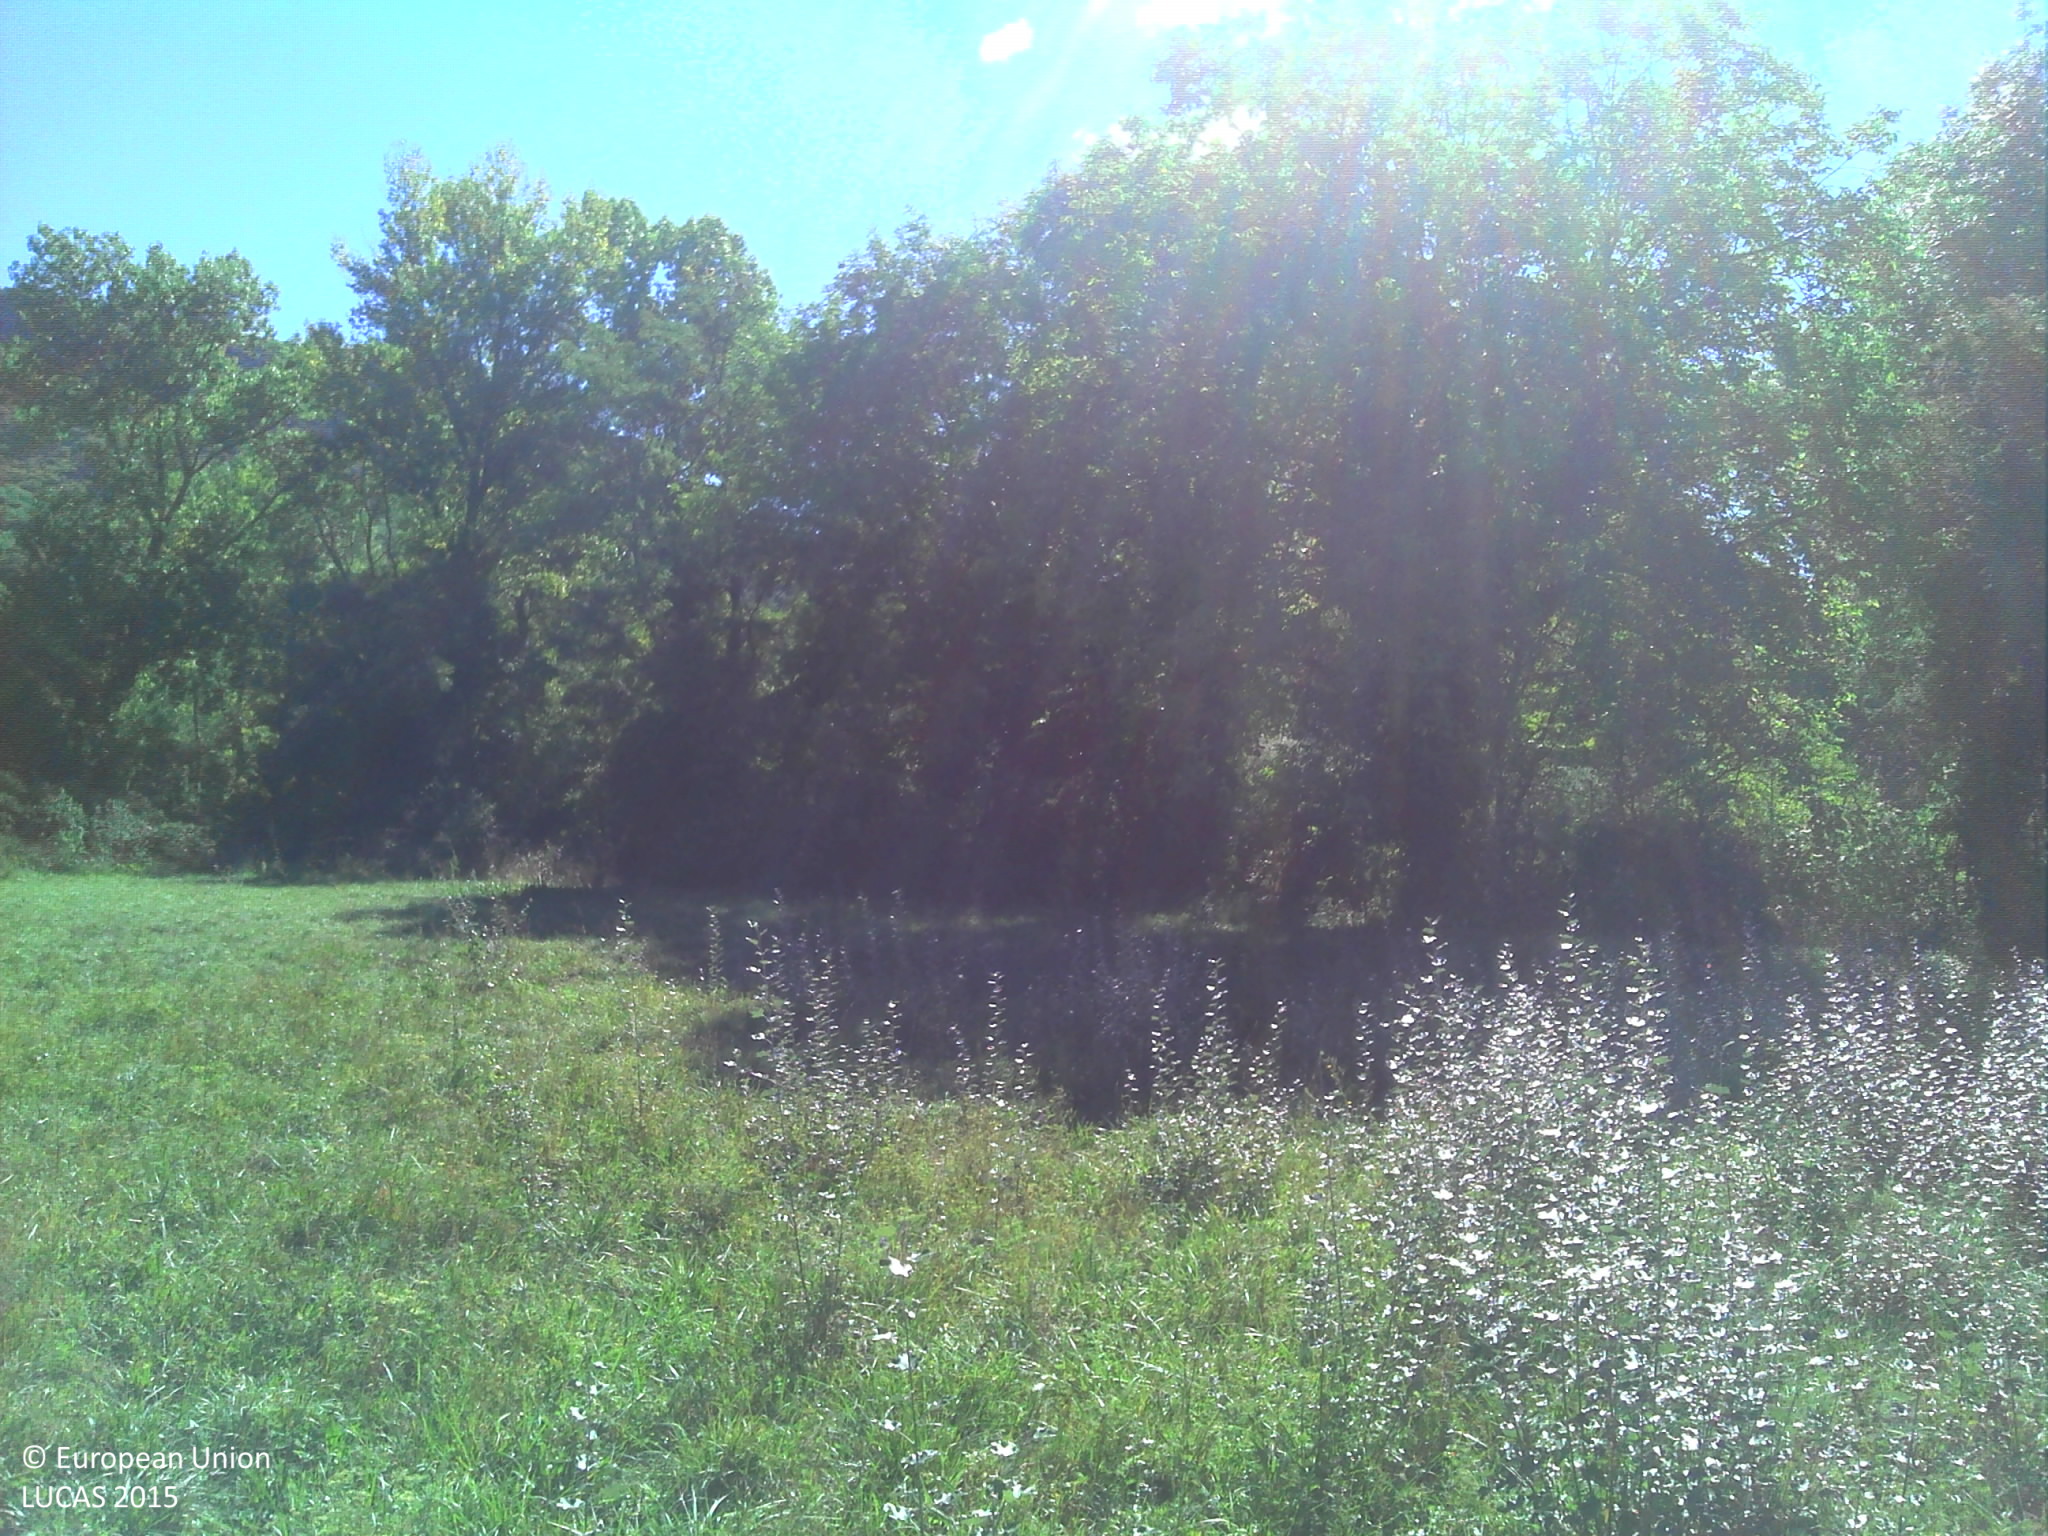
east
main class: Grassland
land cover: Grassland without tree/shrub cover
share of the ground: > 75 %
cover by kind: herbaceous plants 100 %
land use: Agriculture (excluding fallow land and kitchen gardens)
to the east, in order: Grassland without tree/shrub cover; Ditches and canals; Artificial constructions in urban areas; Broadleaved woodland; Rivers and streams; Broadleaved woodland; Paved roads, cycling and walking lanes; Broadleaved woodland
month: November
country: FR
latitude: 44.4020
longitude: 5.1983
